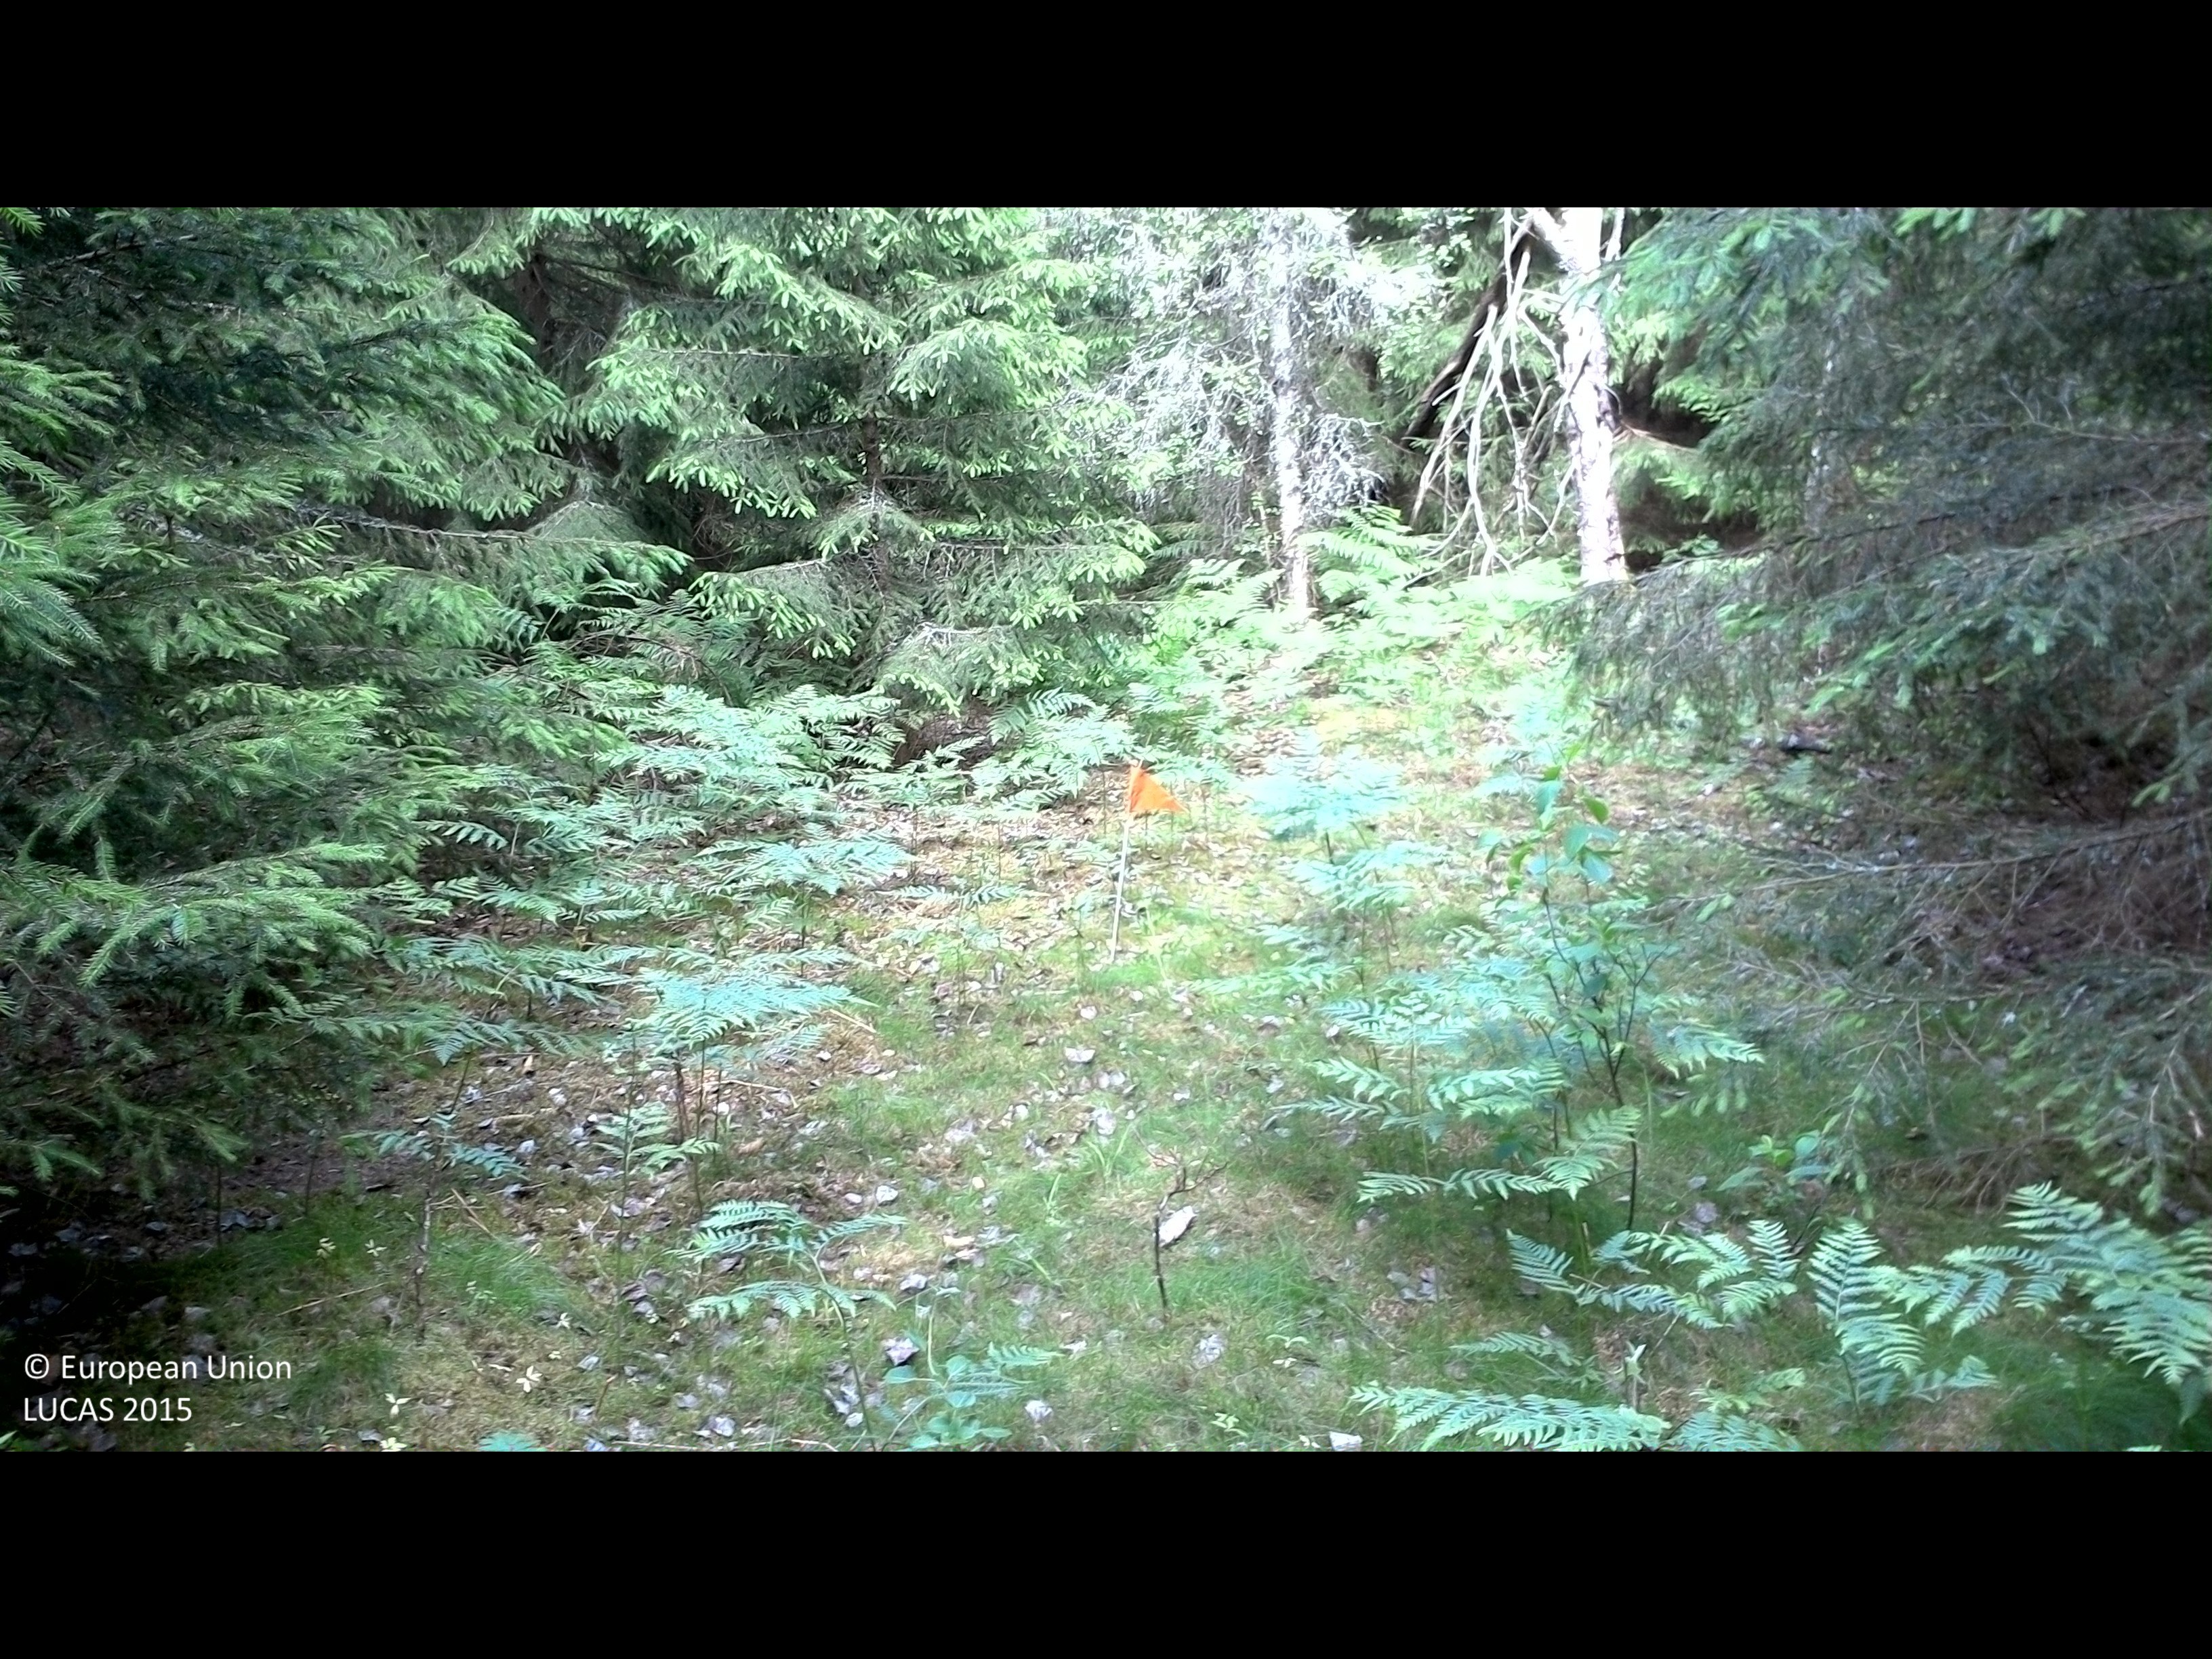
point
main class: Woodland
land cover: Spruce dominated coniferous woodland
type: boreal forest
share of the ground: > 75 %
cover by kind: coniferous forest trees 70 %, herbaceous plants 15 %, broadleaved forest trees 5 %, shrubs 5 %, lichens and mosses 5 %
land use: Forestry
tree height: > 5 m
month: July
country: SE
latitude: 56.4768
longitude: 14.7873
